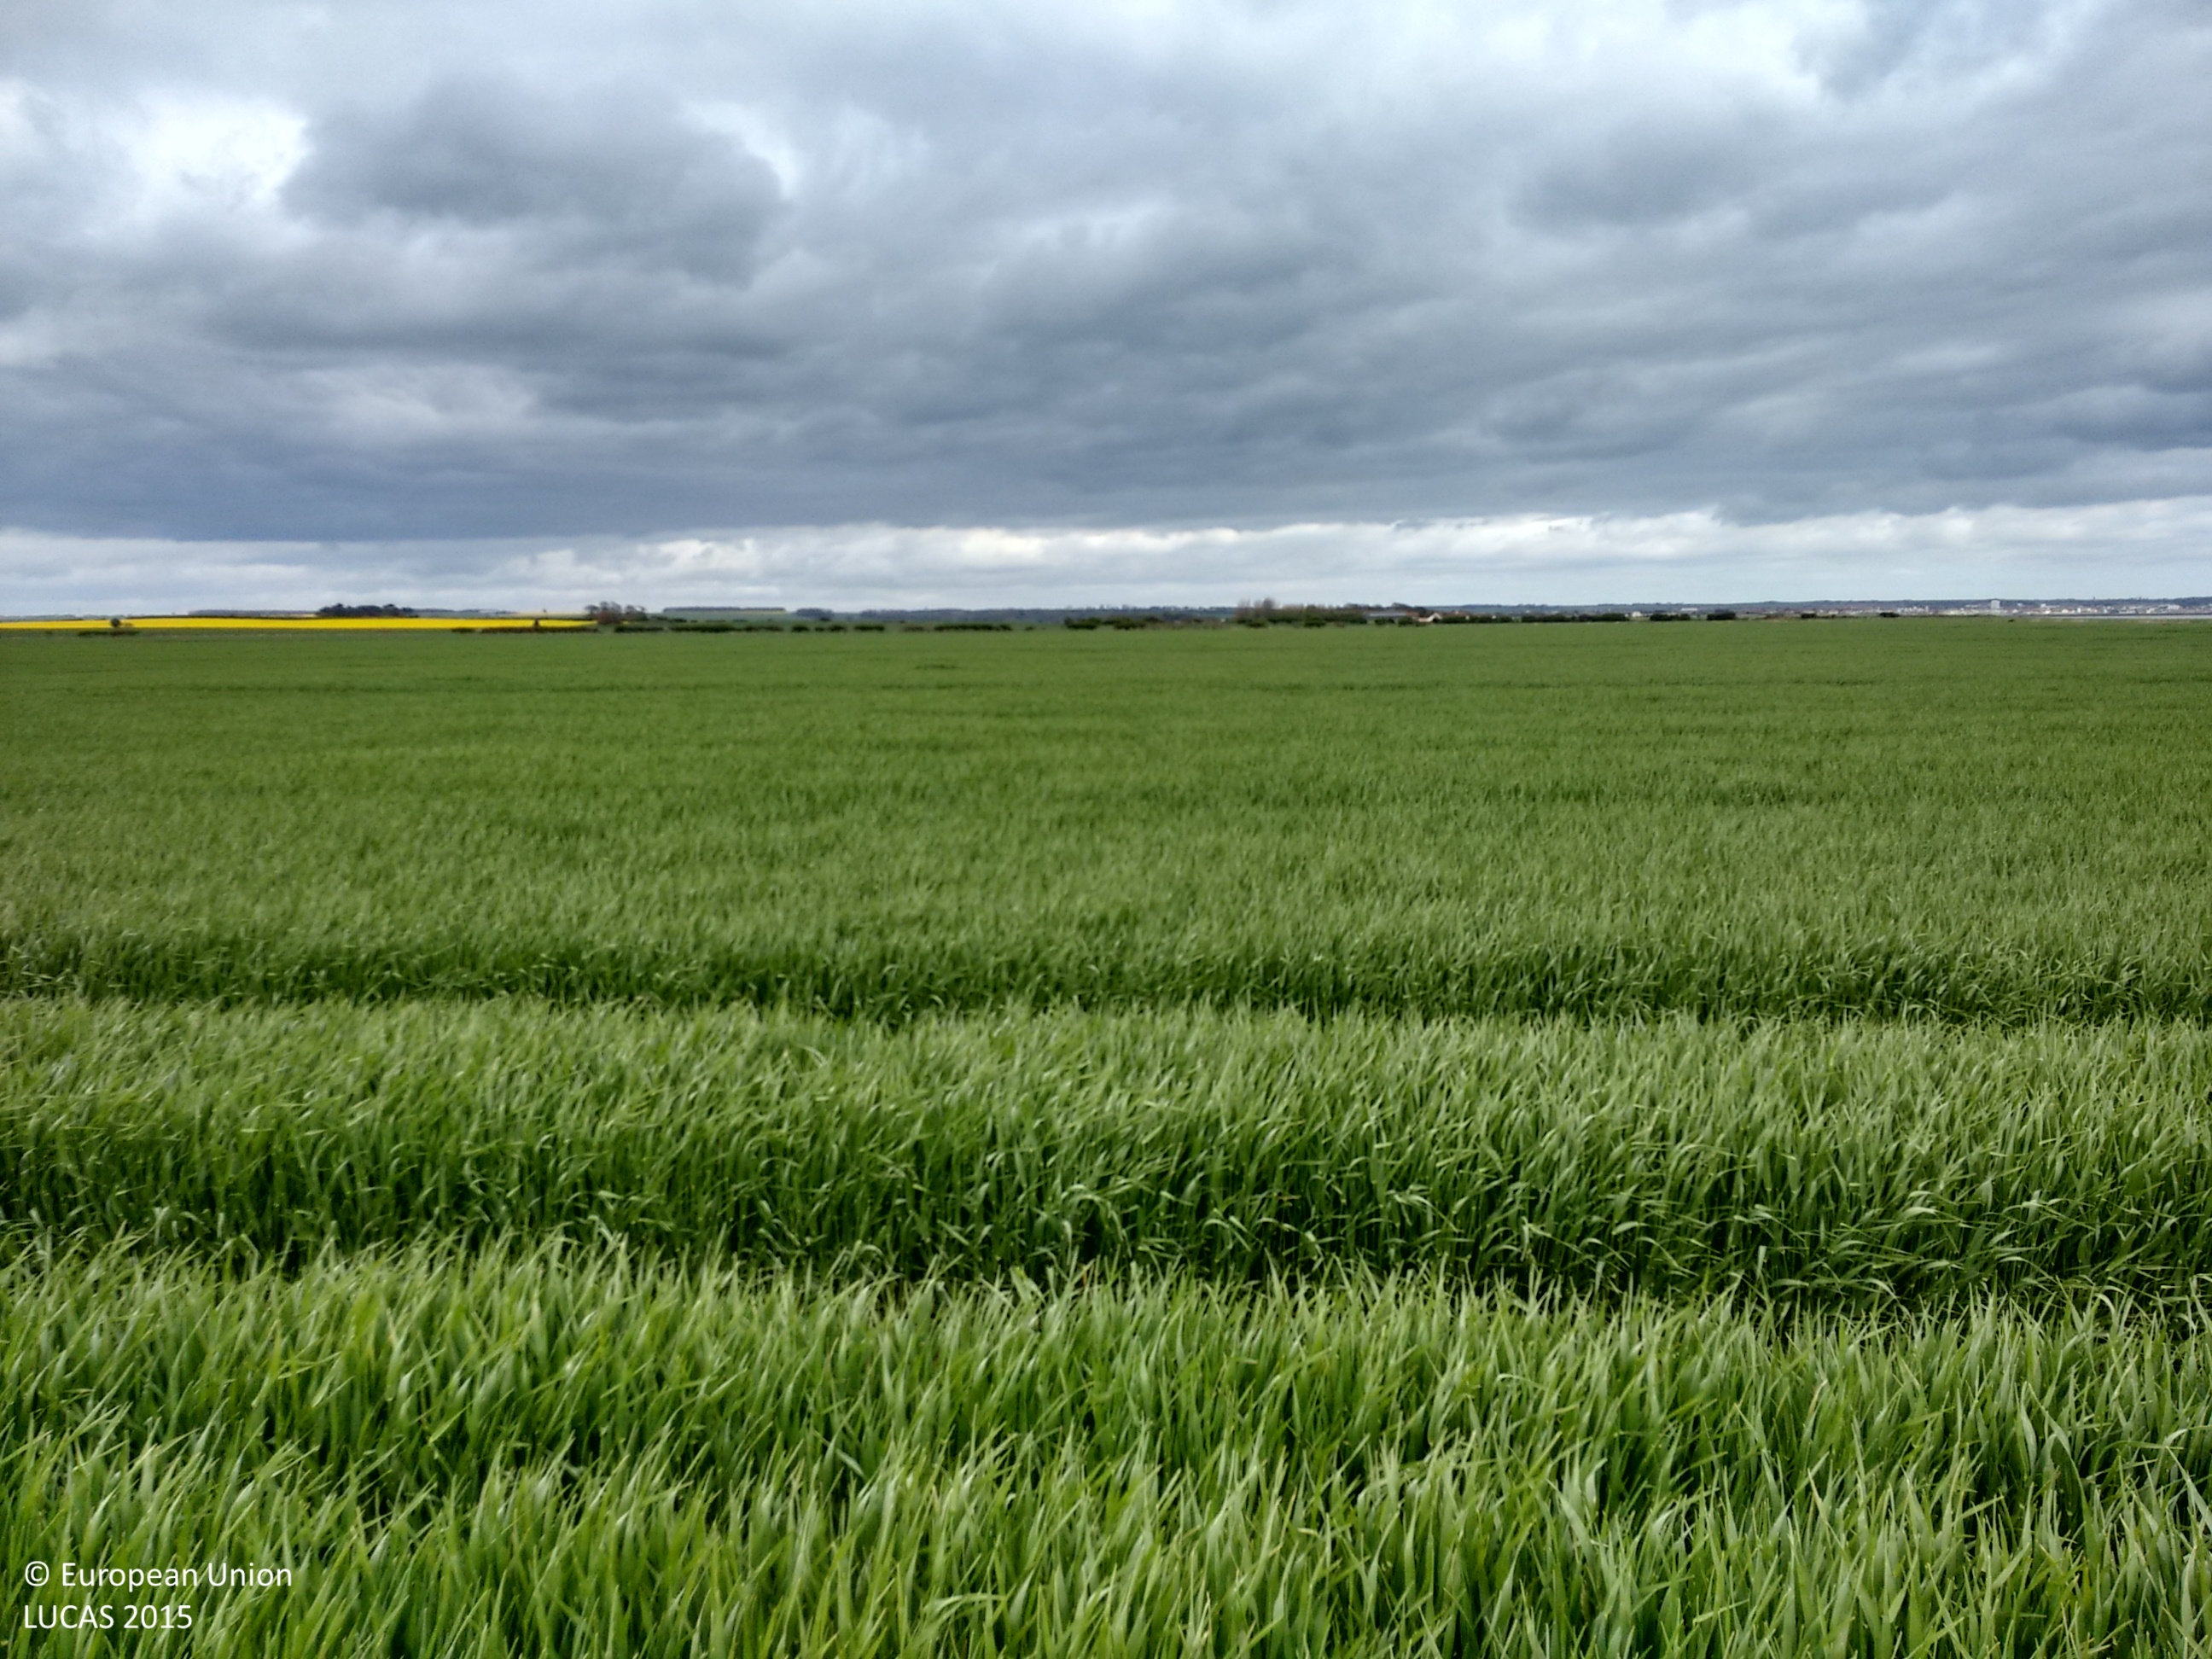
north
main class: Cropland
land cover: Barley
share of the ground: > 75 %
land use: Agriculture (excluding fallow land and kitchen gardens)
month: May
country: GB
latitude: 54.0381
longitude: -0.2181
